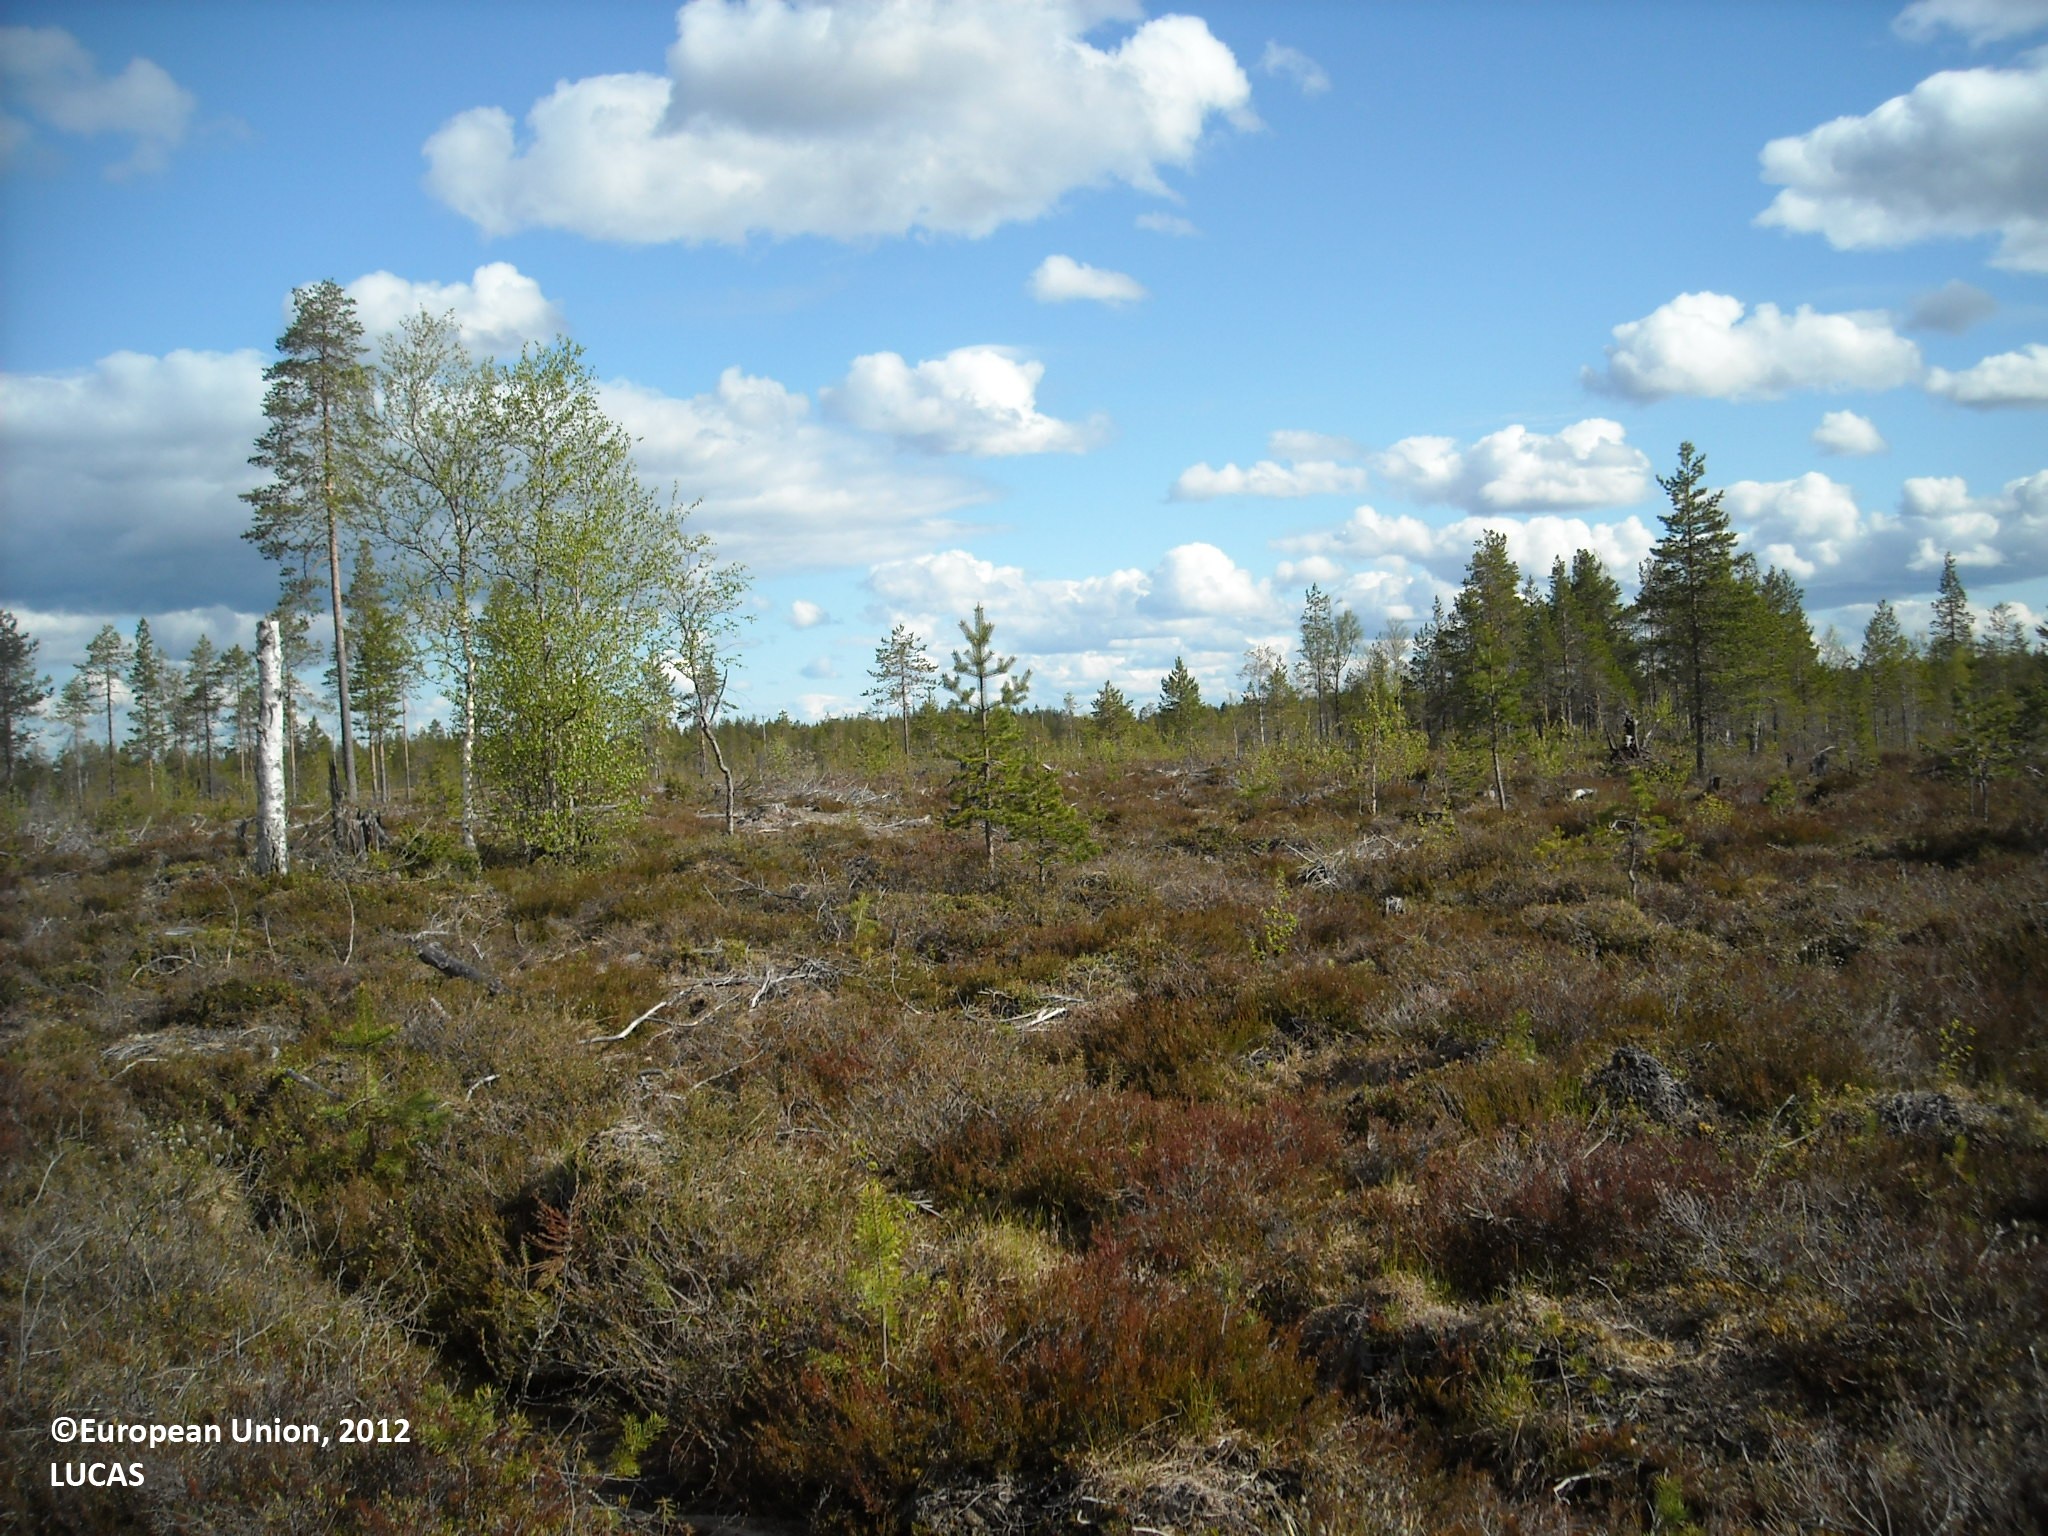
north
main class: Shrubland
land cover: Shrubland with sparse tree cover
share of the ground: > 75 %
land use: Forestry
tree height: < 5 m
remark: Clear cut
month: May
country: FI
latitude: 64.7565
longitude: 27.3035
